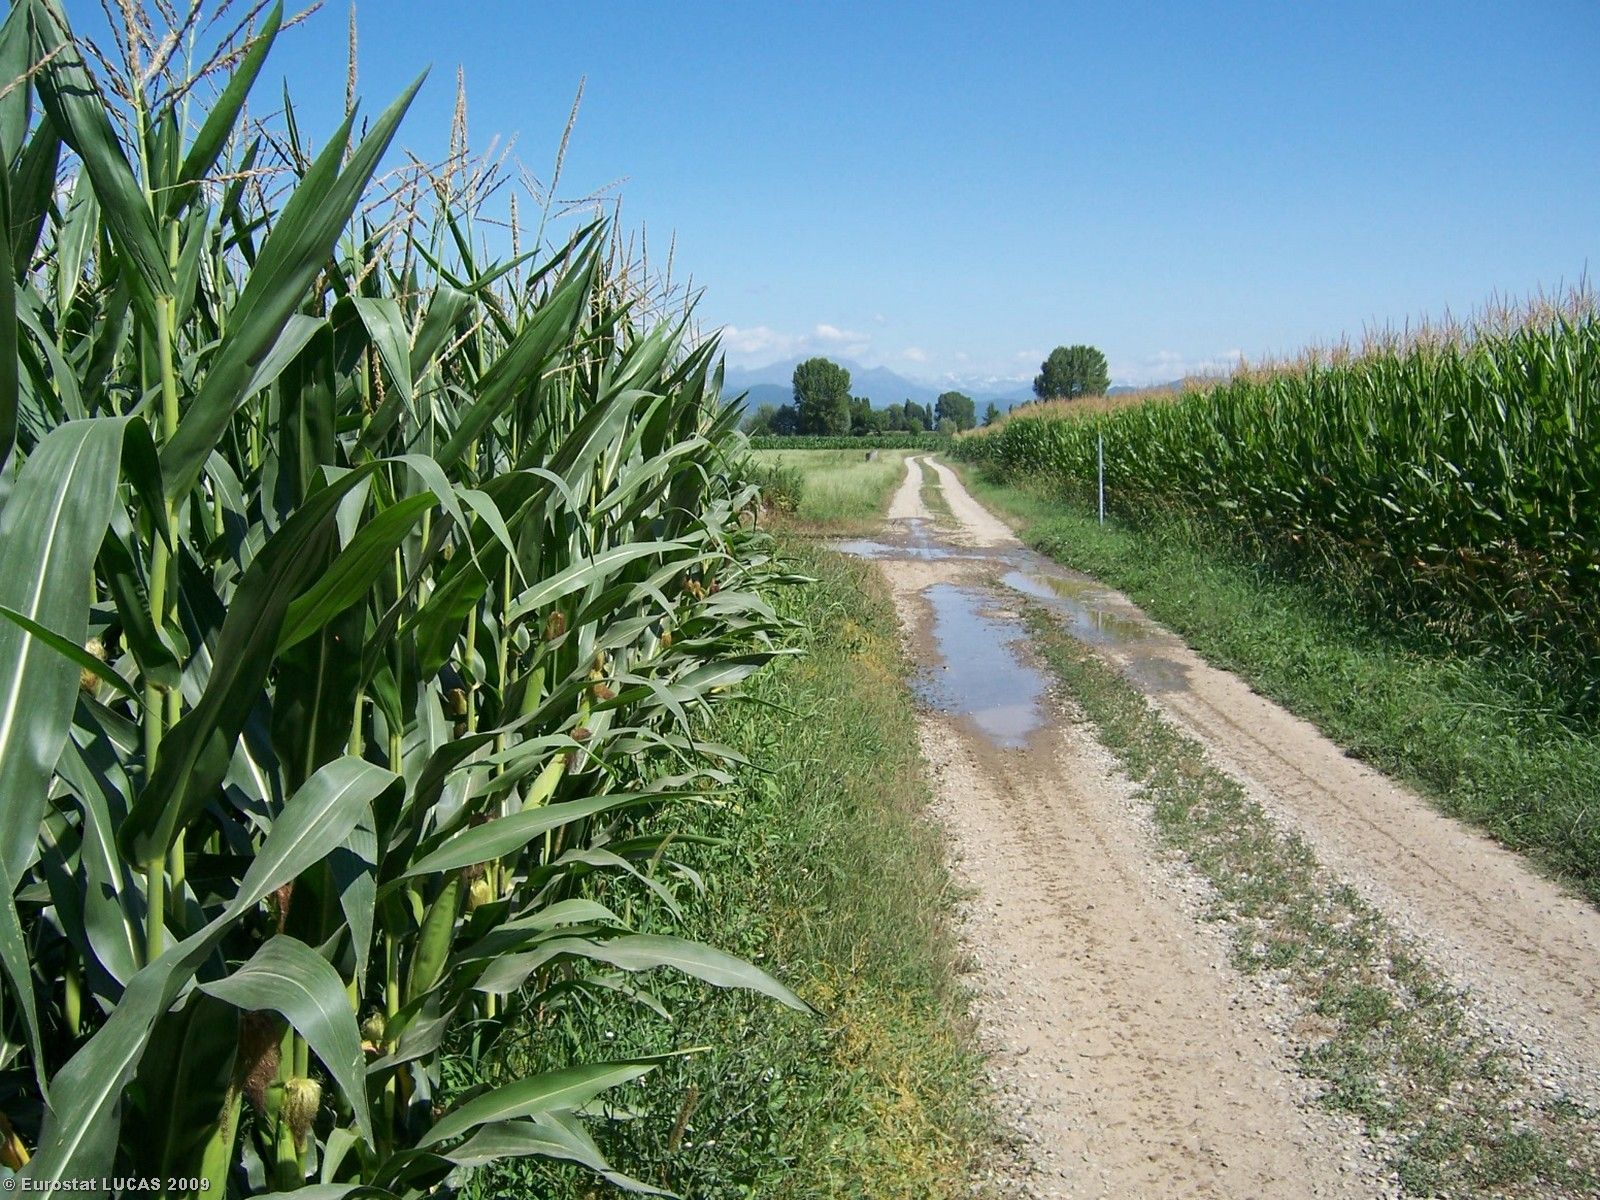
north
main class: Cropland
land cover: Maize
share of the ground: > 75 %
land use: Agriculture (excluding fallow land and kitchen gardens)
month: July
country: IT
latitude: 44.8775
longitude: 7.4096
